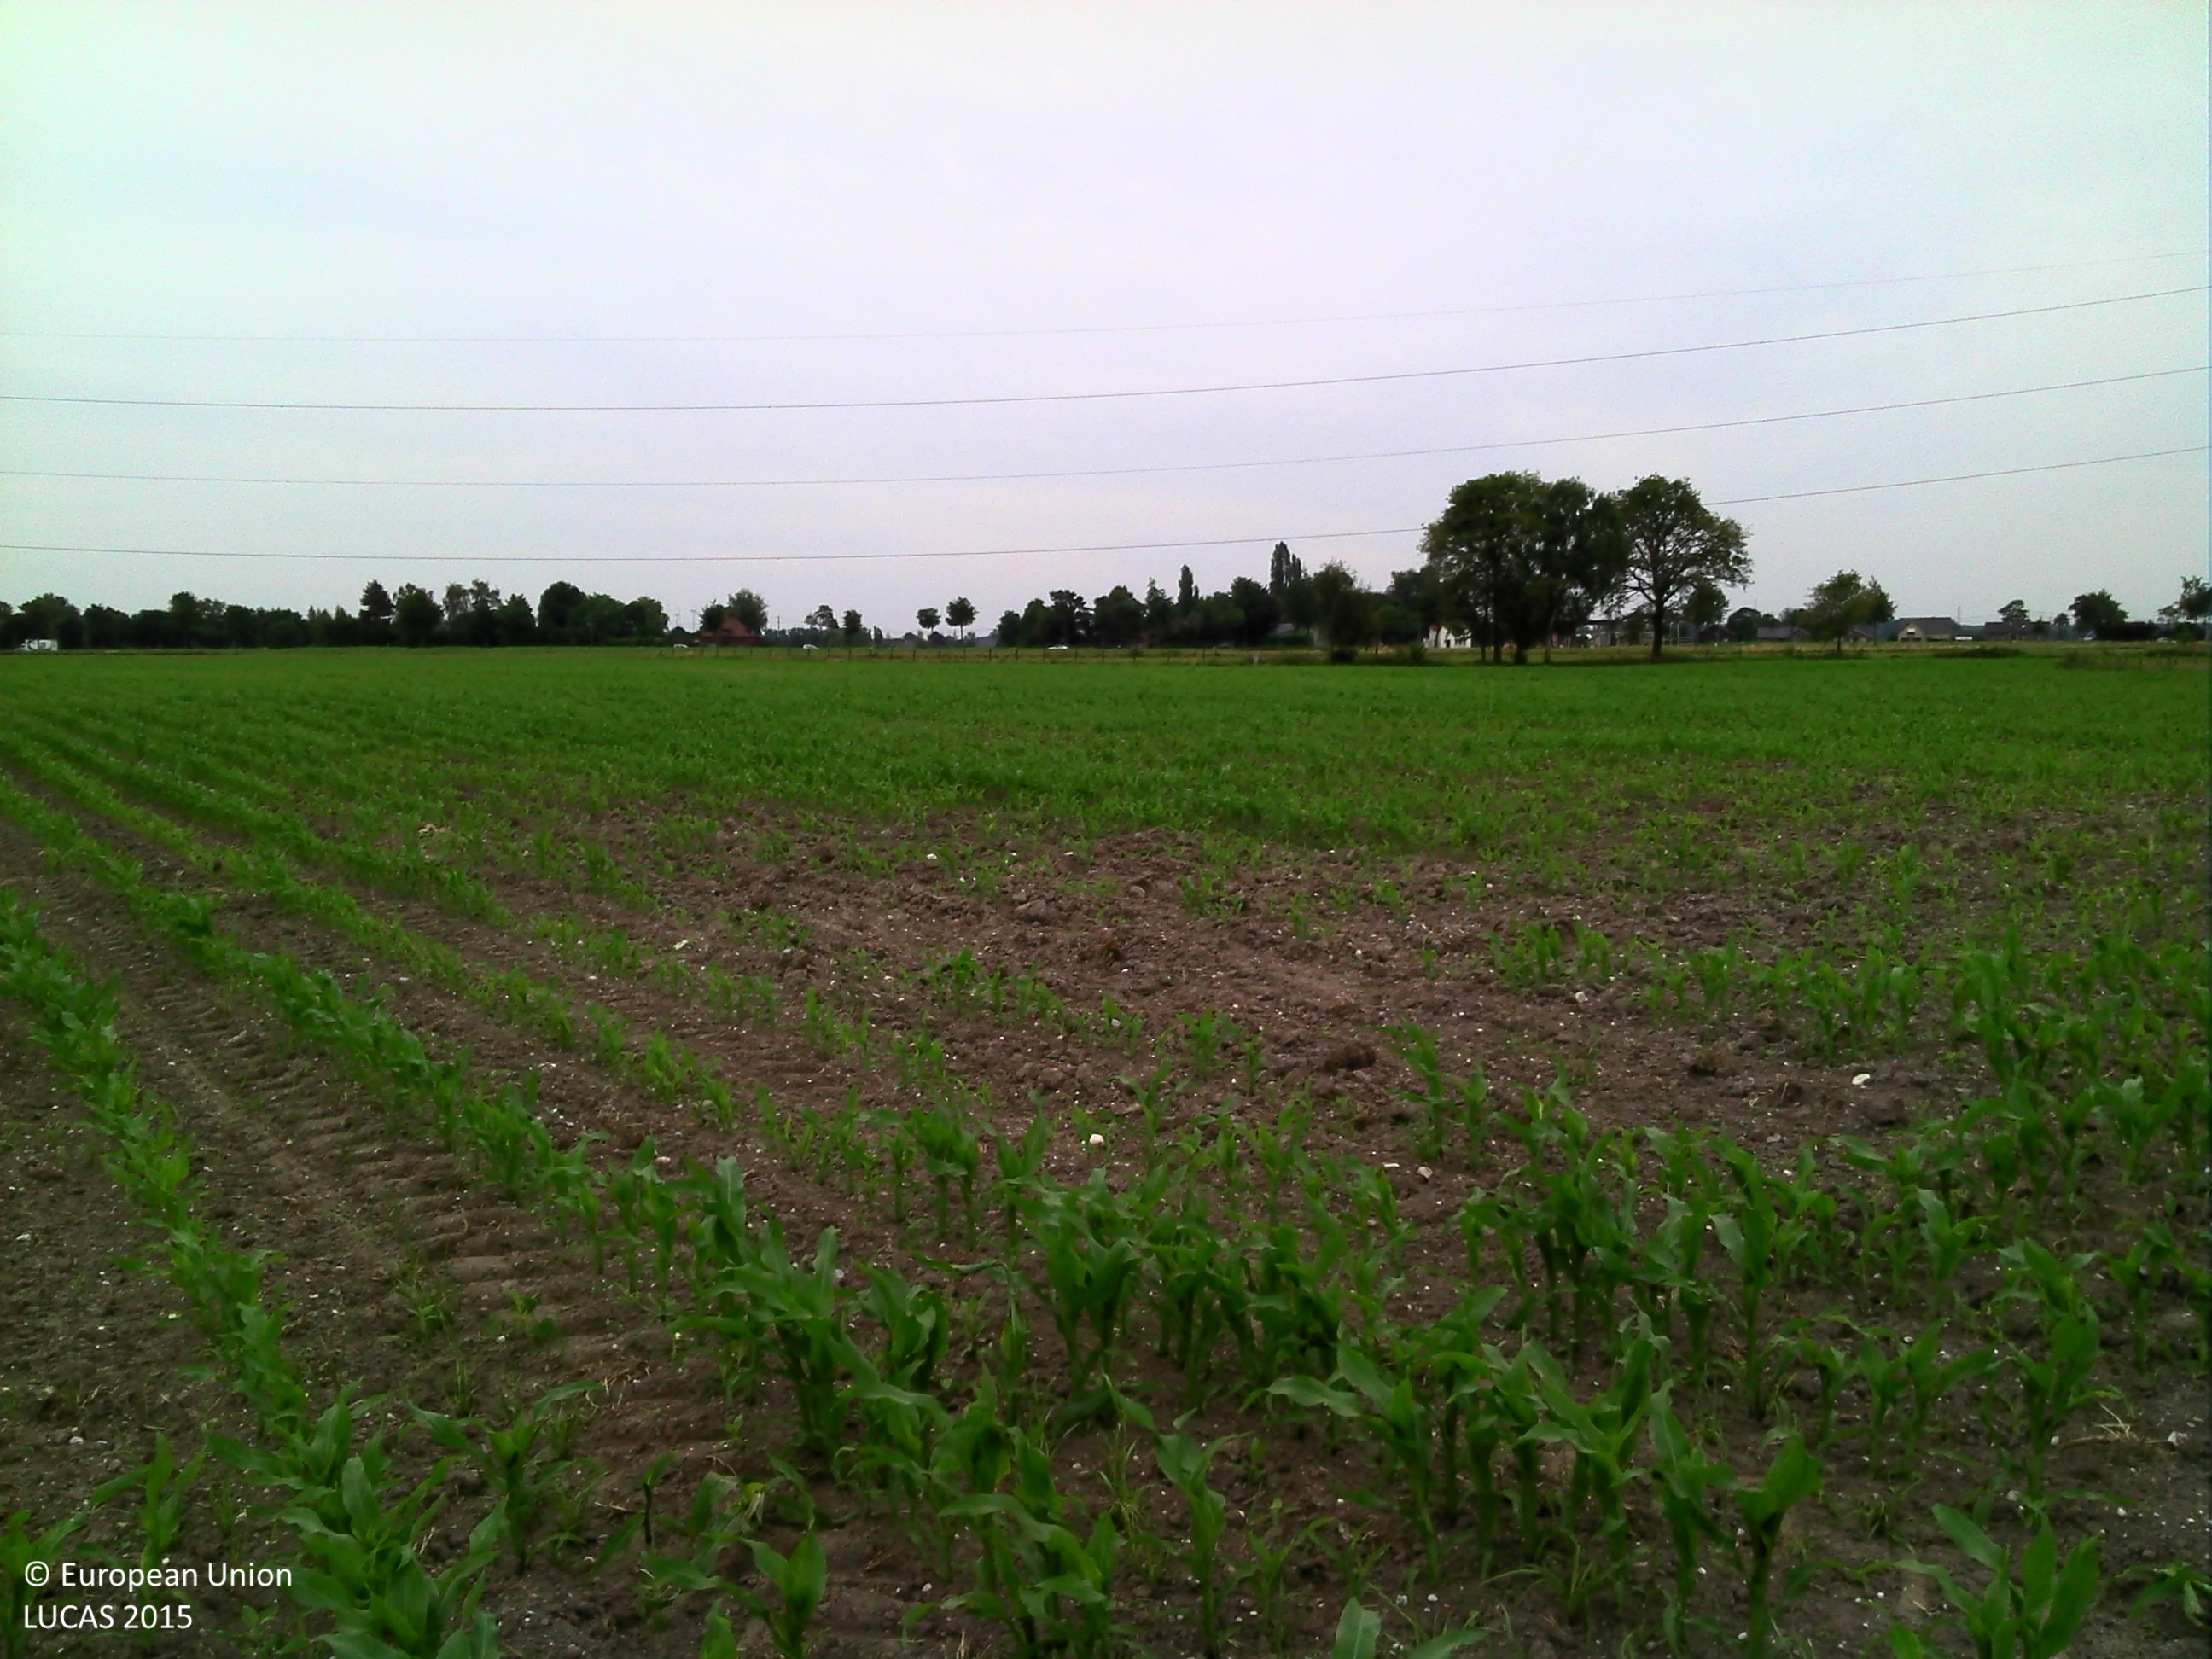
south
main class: Cropland
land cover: Maize
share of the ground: 10 - 25 %
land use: Agriculture (excluding fallow land and kitchen gardens)
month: June
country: BE
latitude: 51.1463
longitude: 5.6671
